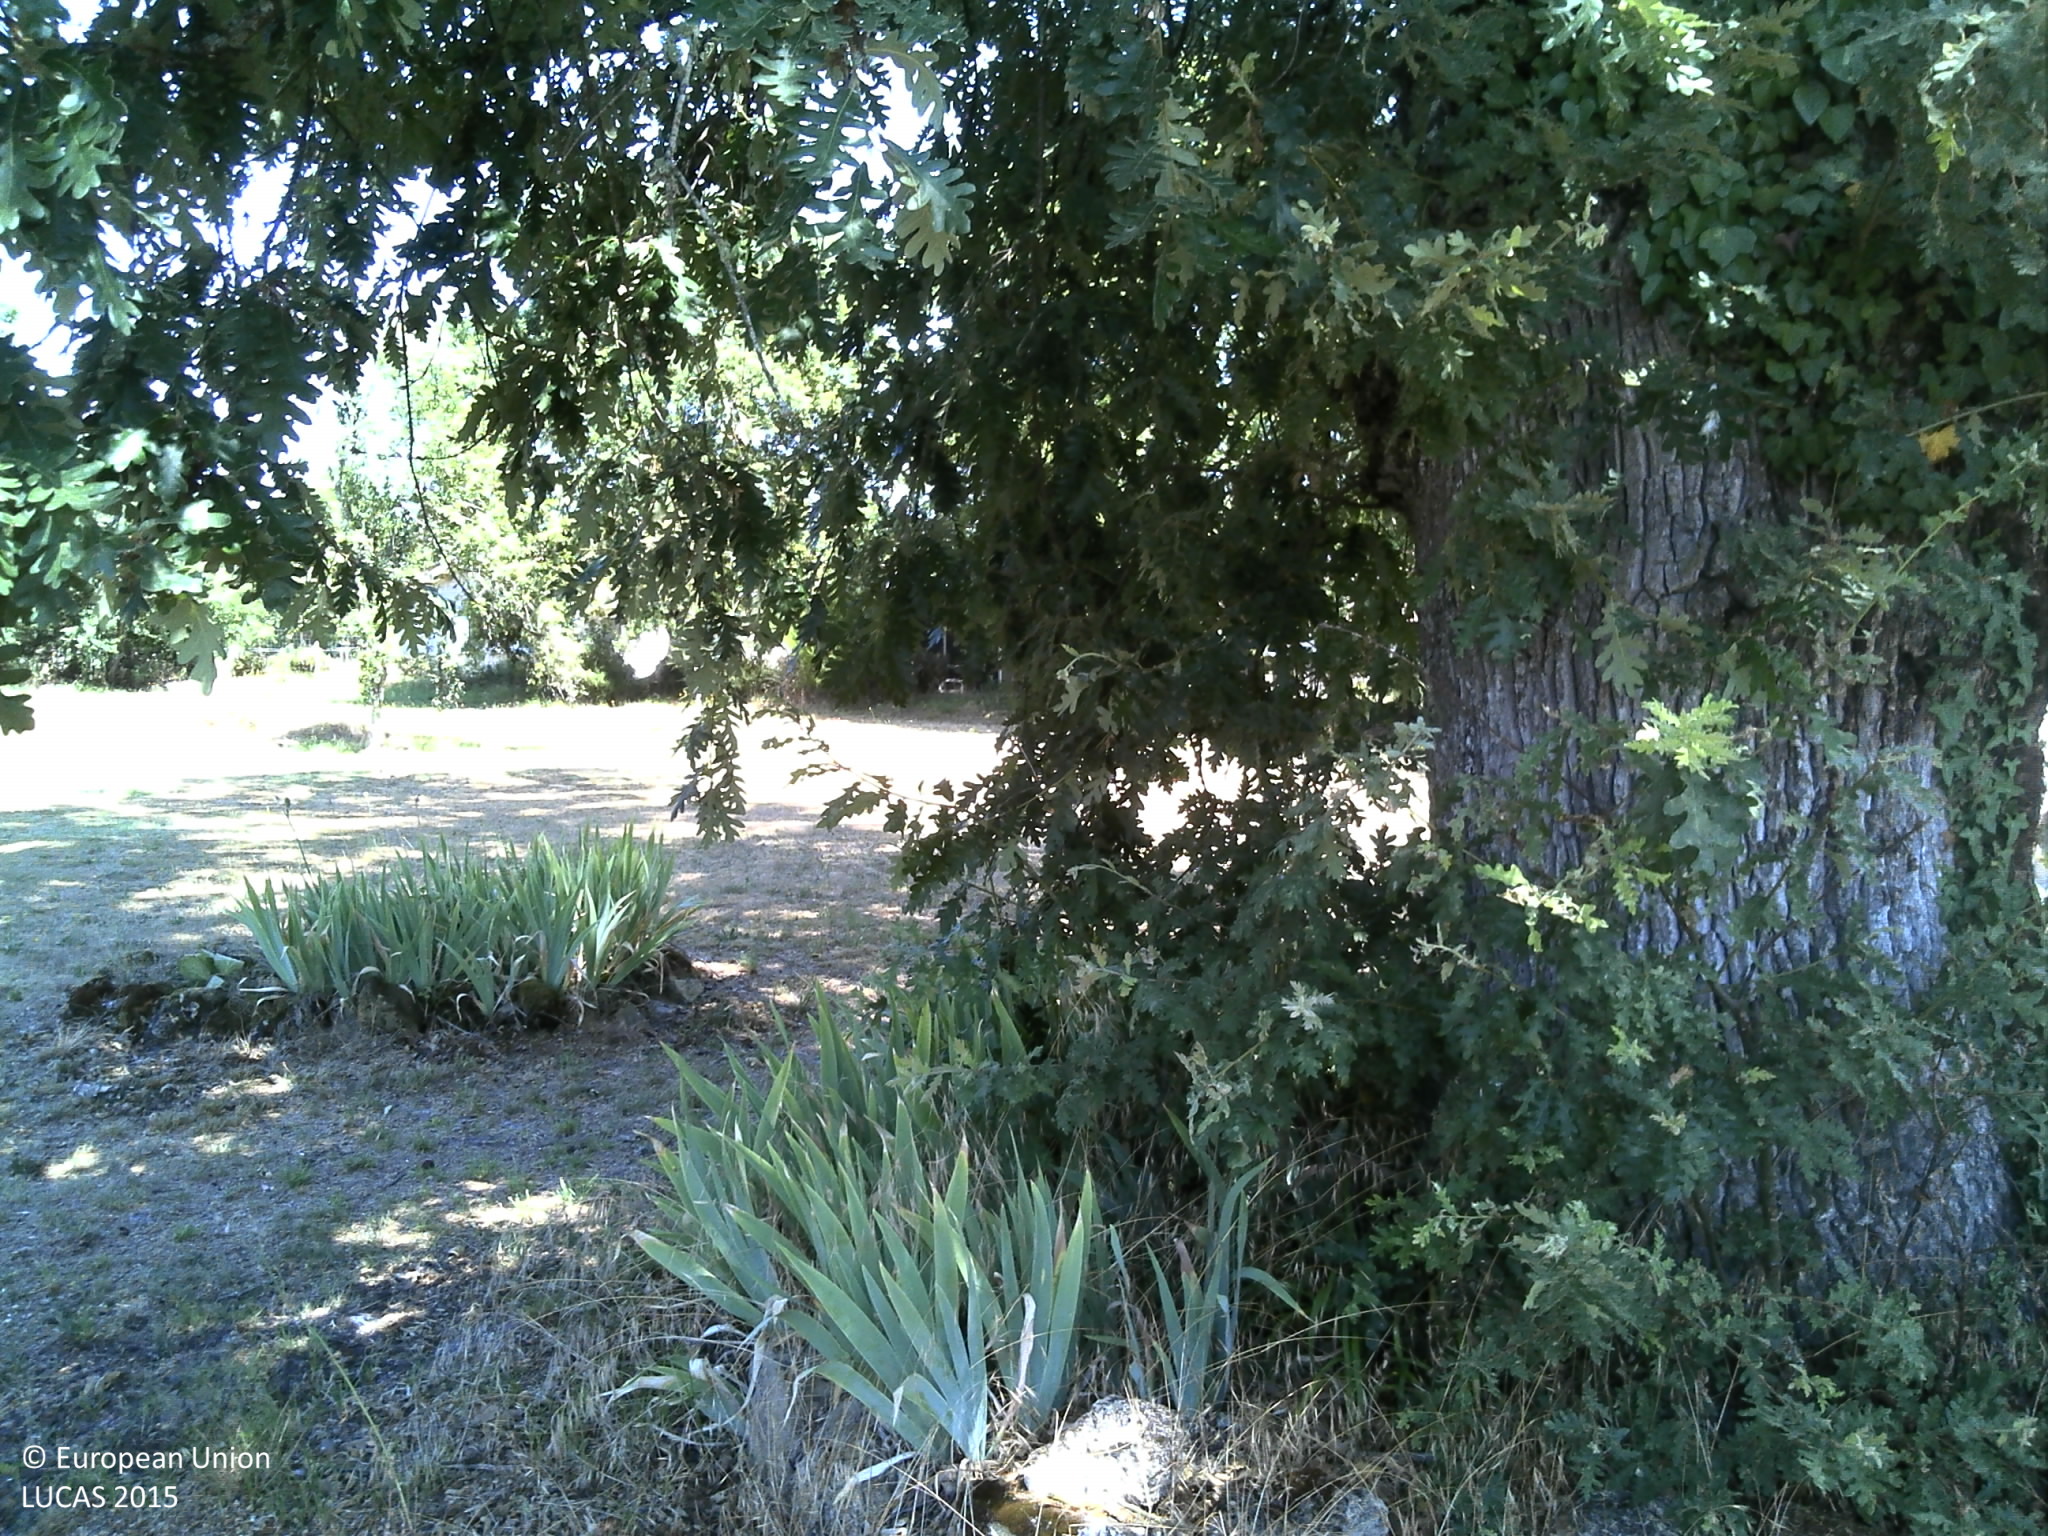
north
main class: Grassland
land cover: Grassland with sparse tree/shrub cover
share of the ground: > 75 %
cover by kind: herbaceous plants 85 %, broadleaved forest trees 5 %, shrubs 5 %, lichens and mosses 5 %
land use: Residential
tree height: < 5 m
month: July
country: FR
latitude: 44.3775
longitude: -0.3429
